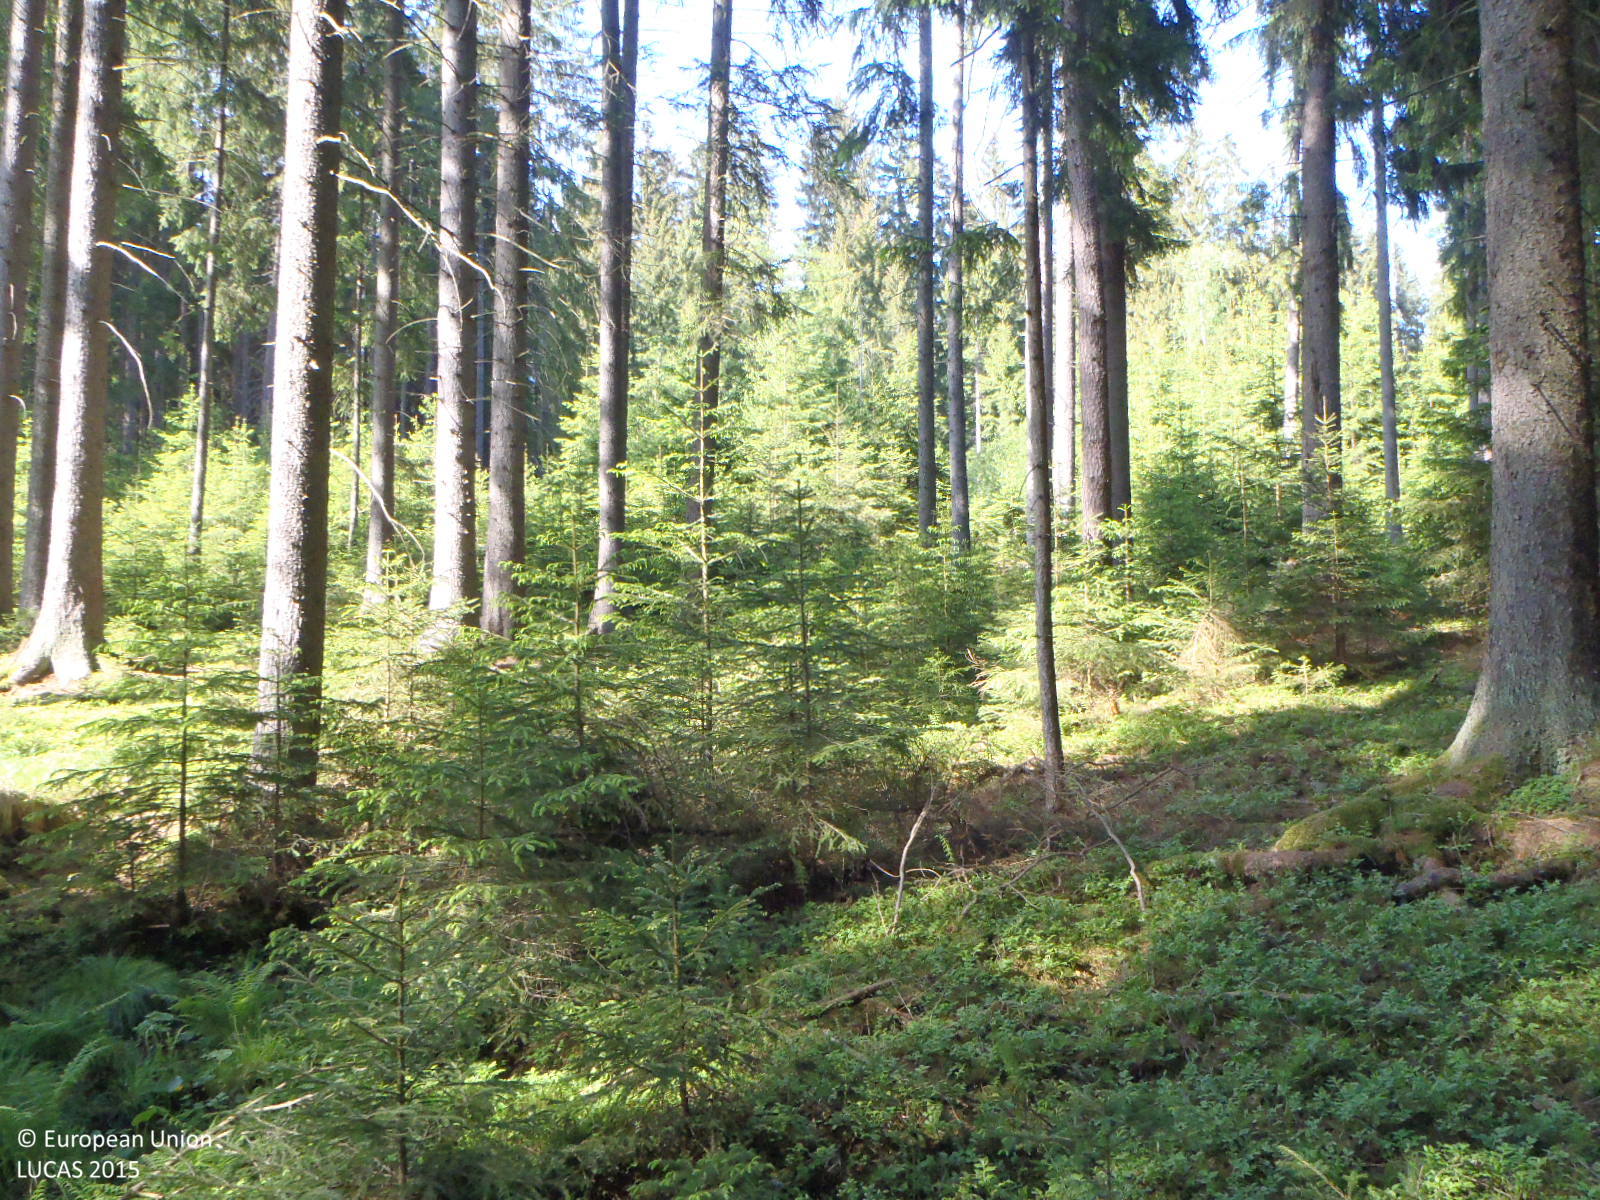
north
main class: Woodland
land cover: Spruce dominated coniferous woodland
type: hemiboreal forest and nemoral coniferous forest and mixed broadleaved-coniferous forest
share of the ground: > 75 %
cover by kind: coniferous forest trees 85 %, shrubs 10 %, lichens and mosses 5 %
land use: Forestry
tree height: > 5 m
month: May
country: CZ
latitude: 48.6523
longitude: 14.5484
